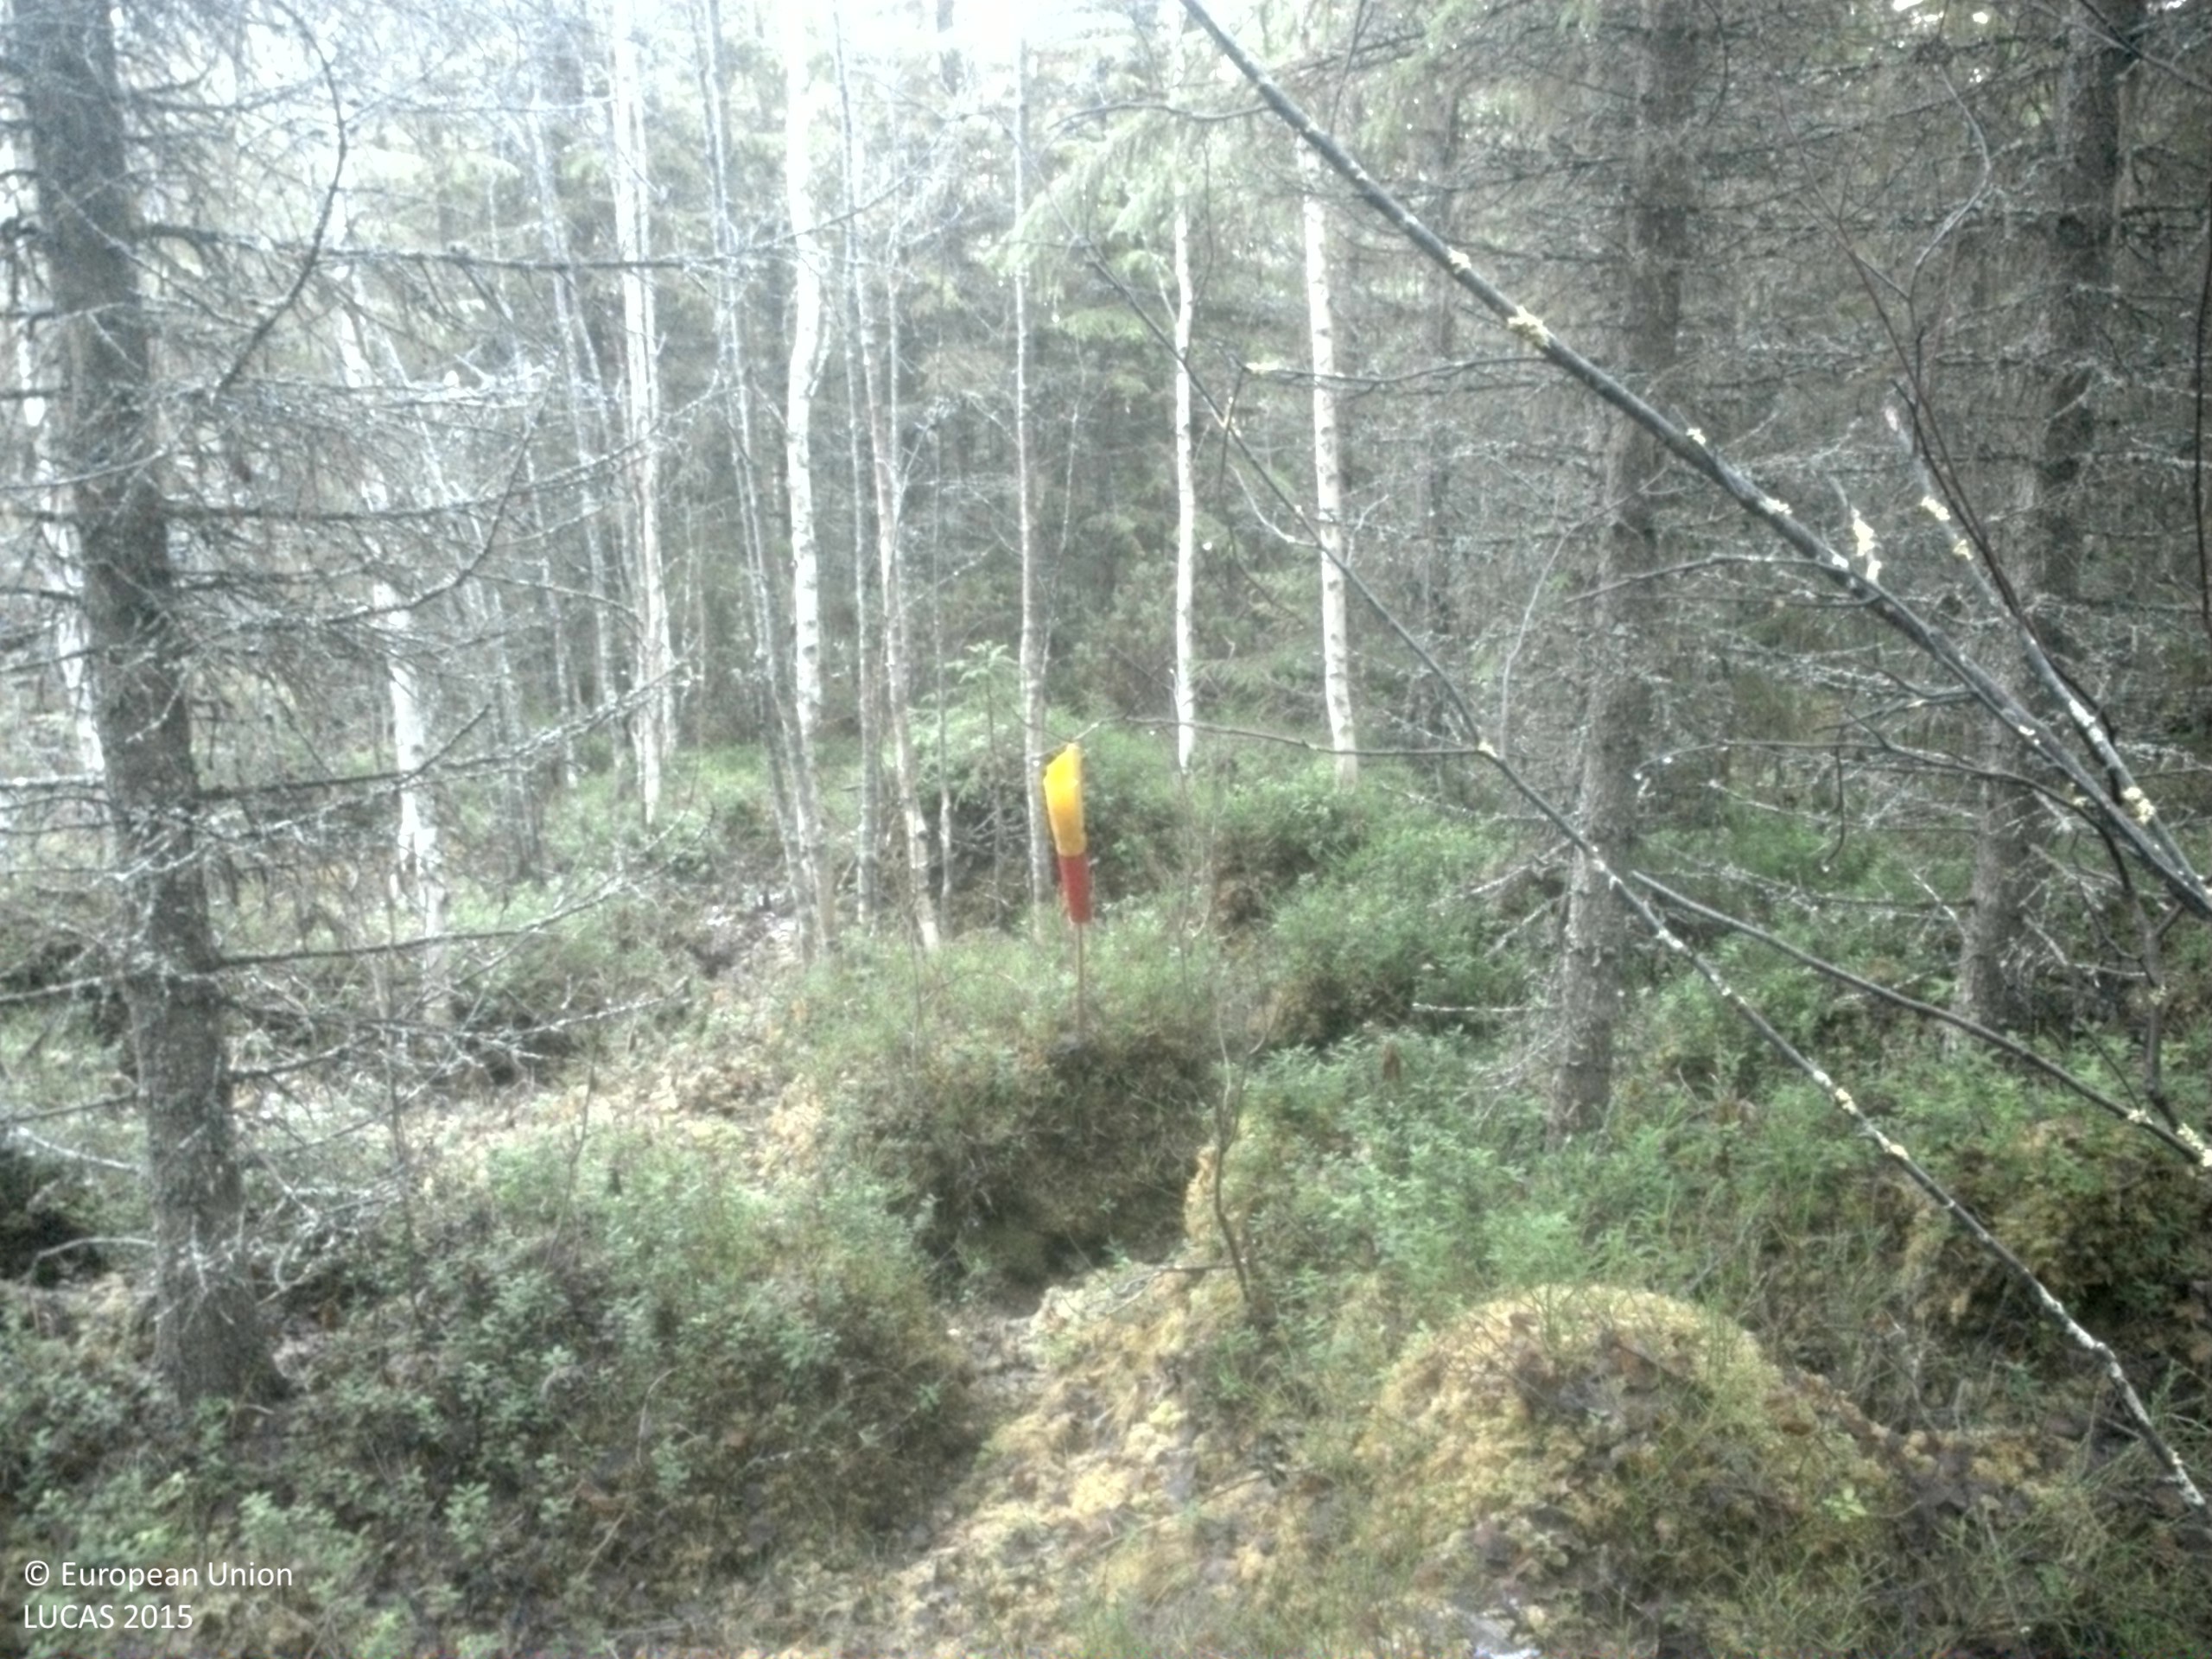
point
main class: Woodland
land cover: Spruce dominated mixed woodland
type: boreal forest
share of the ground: > 75 %
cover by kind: coniferous forest trees 55 %, broadleaved forest trees 20 %, shrubs 15 %, lichens and mosses 10 %
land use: Forestry
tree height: > 5 m
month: November
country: SE
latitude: 63.9081
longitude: 15.9025
